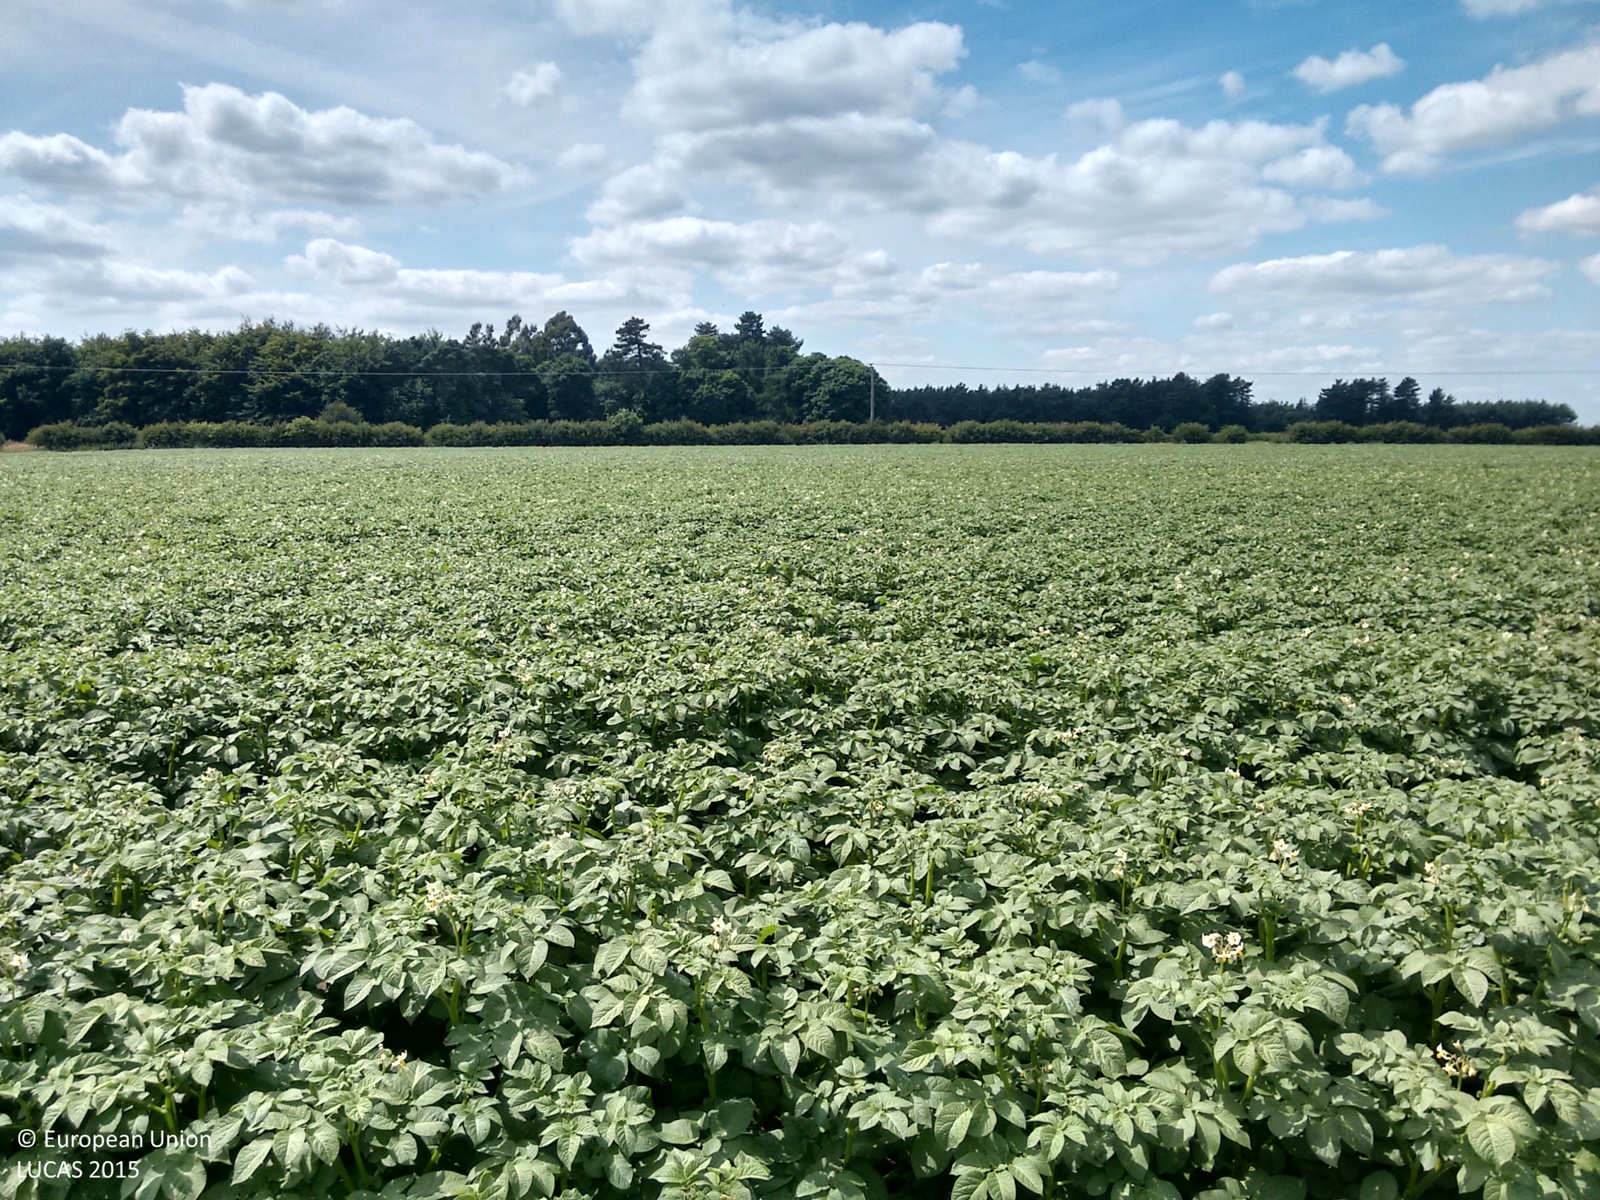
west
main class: Cropland
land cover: Potatoes
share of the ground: > 75 %
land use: Agriculture (excluding fallow land and kitchen gardens)
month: July
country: GB
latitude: 53.3151
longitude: -1.0162
